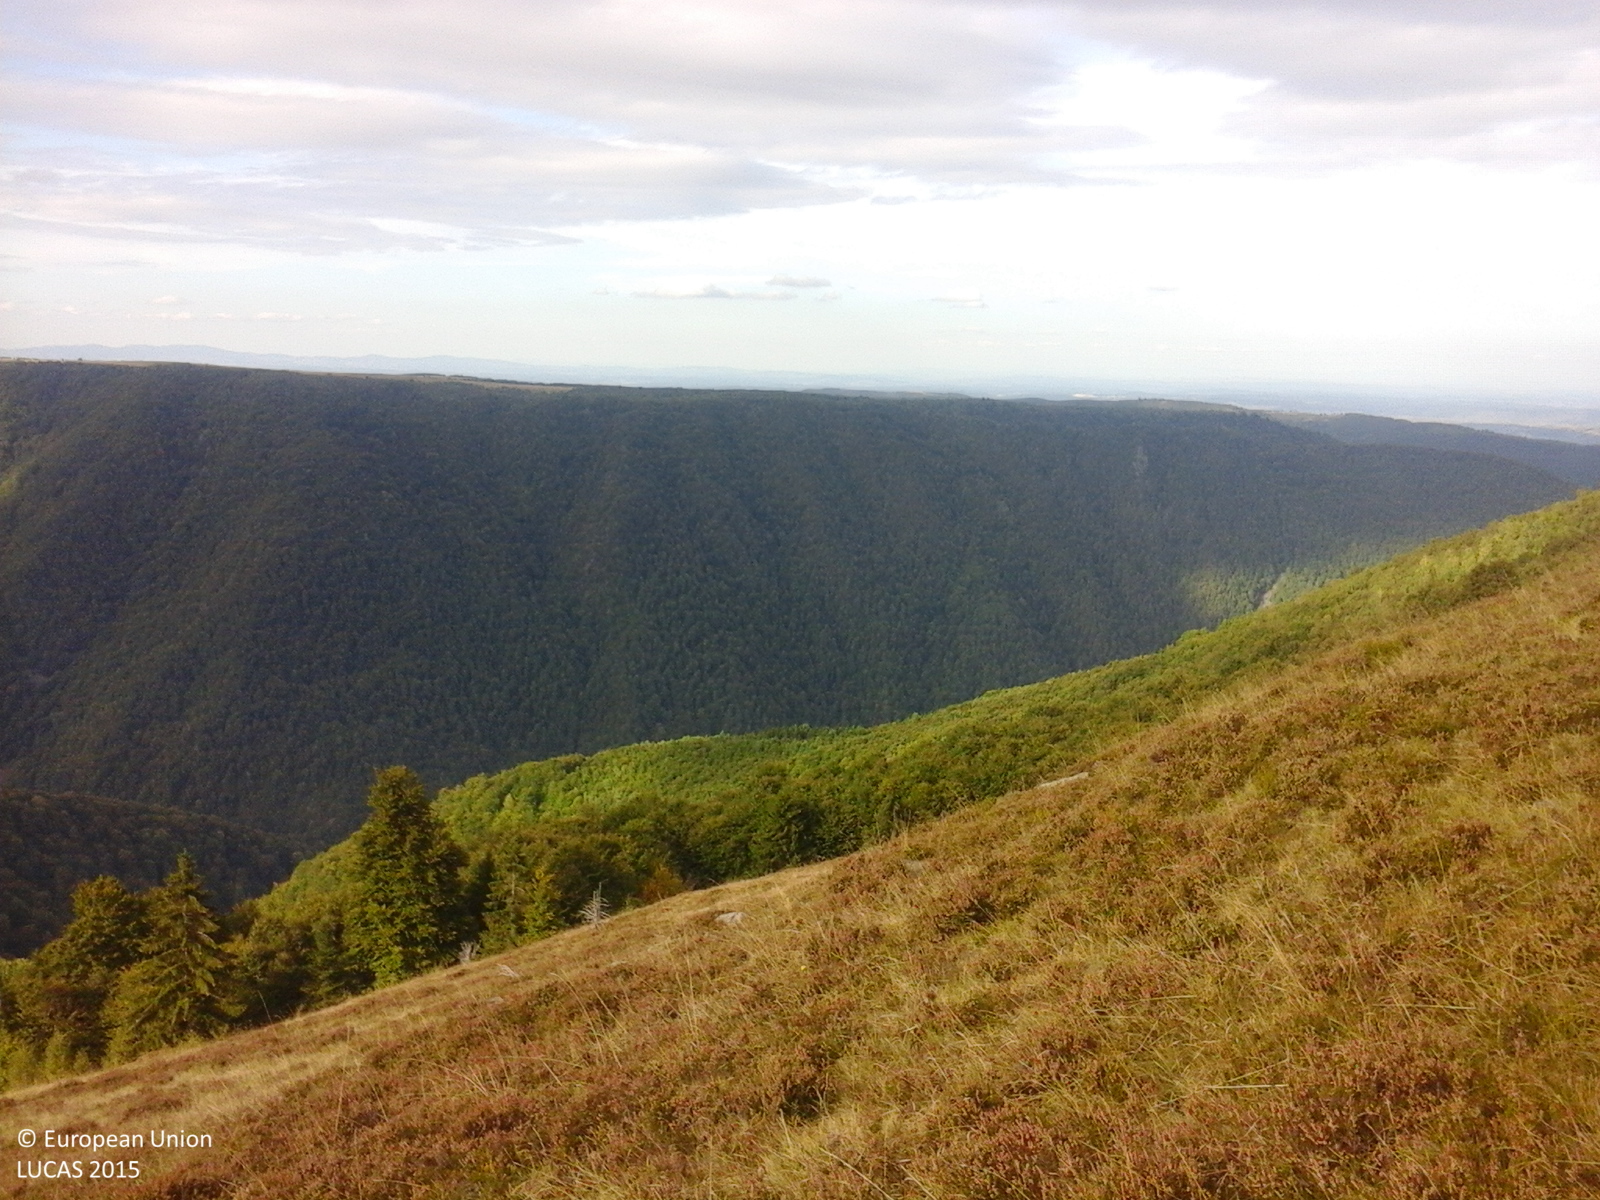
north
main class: Grassland
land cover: Grassland without tree/shrub cover
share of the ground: > 75 %
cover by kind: herbaceous plants 100 %
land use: Agriculture (excluding fallow land and kitchen gardens)
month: October
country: RO
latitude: 46.6922
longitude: 23.2322
